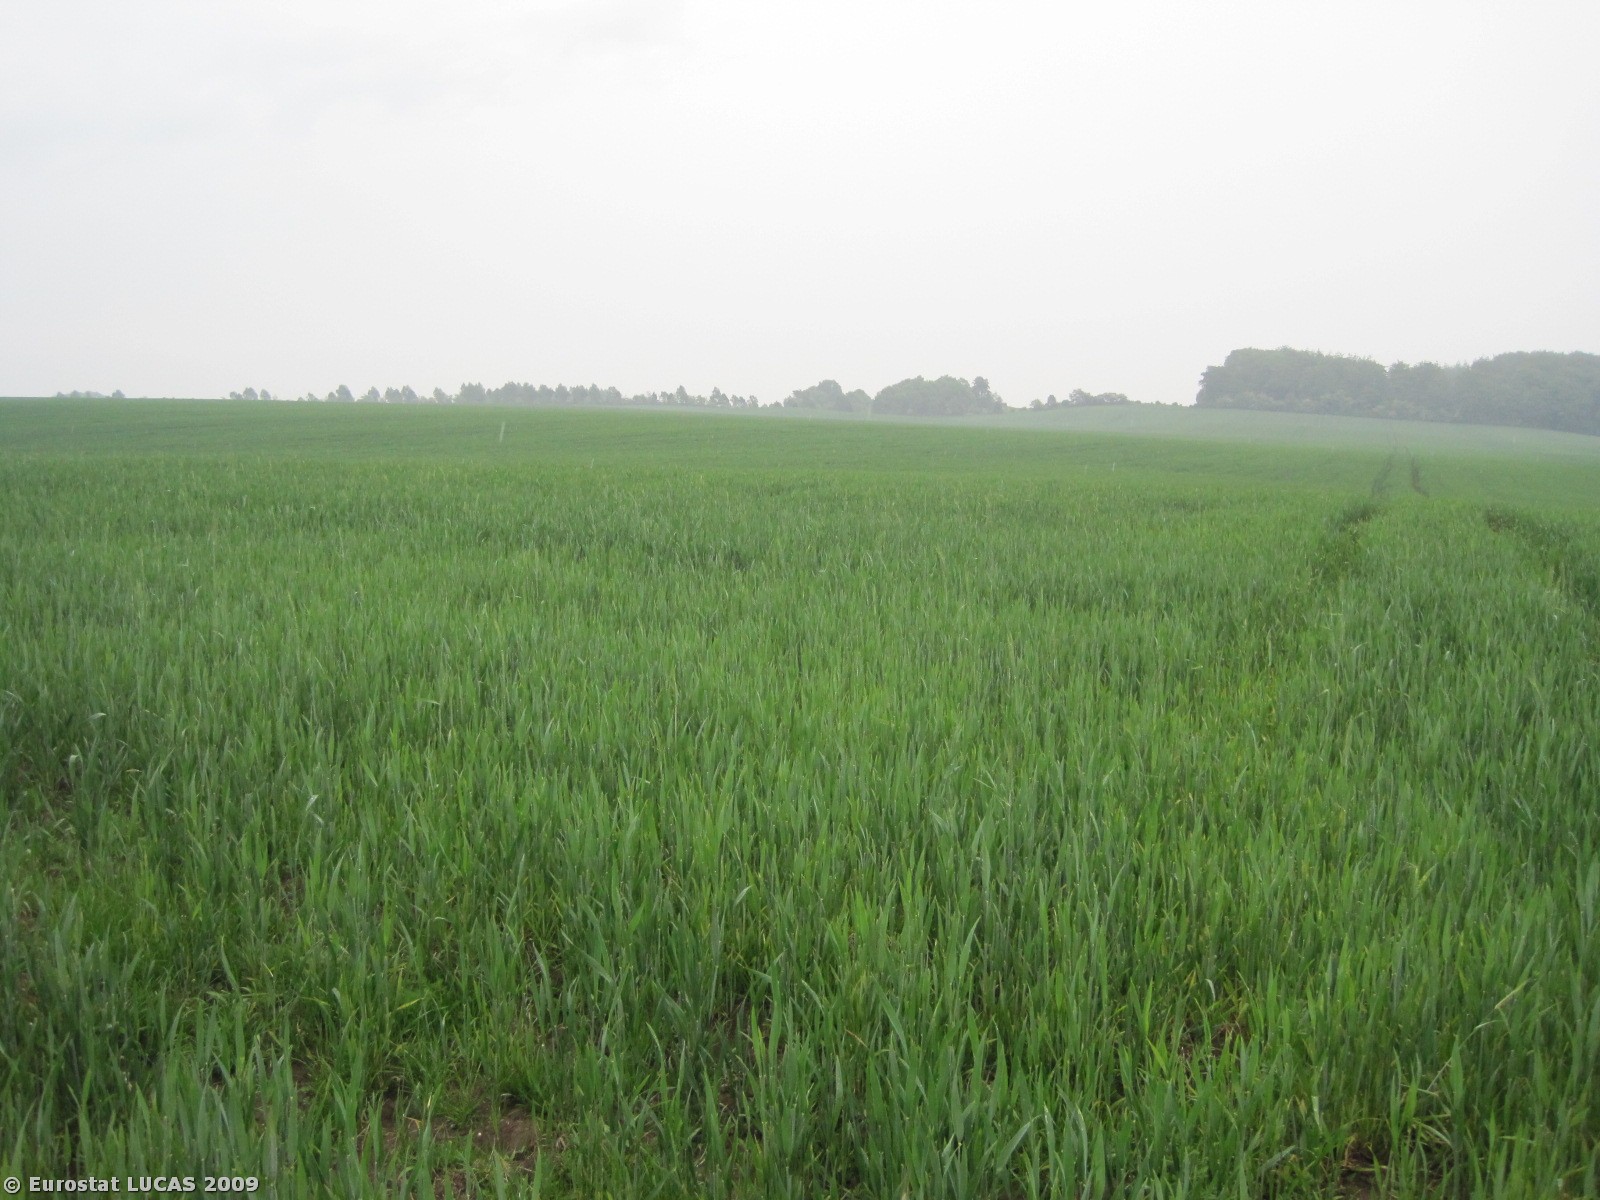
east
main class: Cropland
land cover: Common wheat
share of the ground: > 75 %
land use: Agriculture (excluding fallow land and kitchen gardens)
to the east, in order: Common wheat
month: May
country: DK
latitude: 56.3315
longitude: 9.9192
